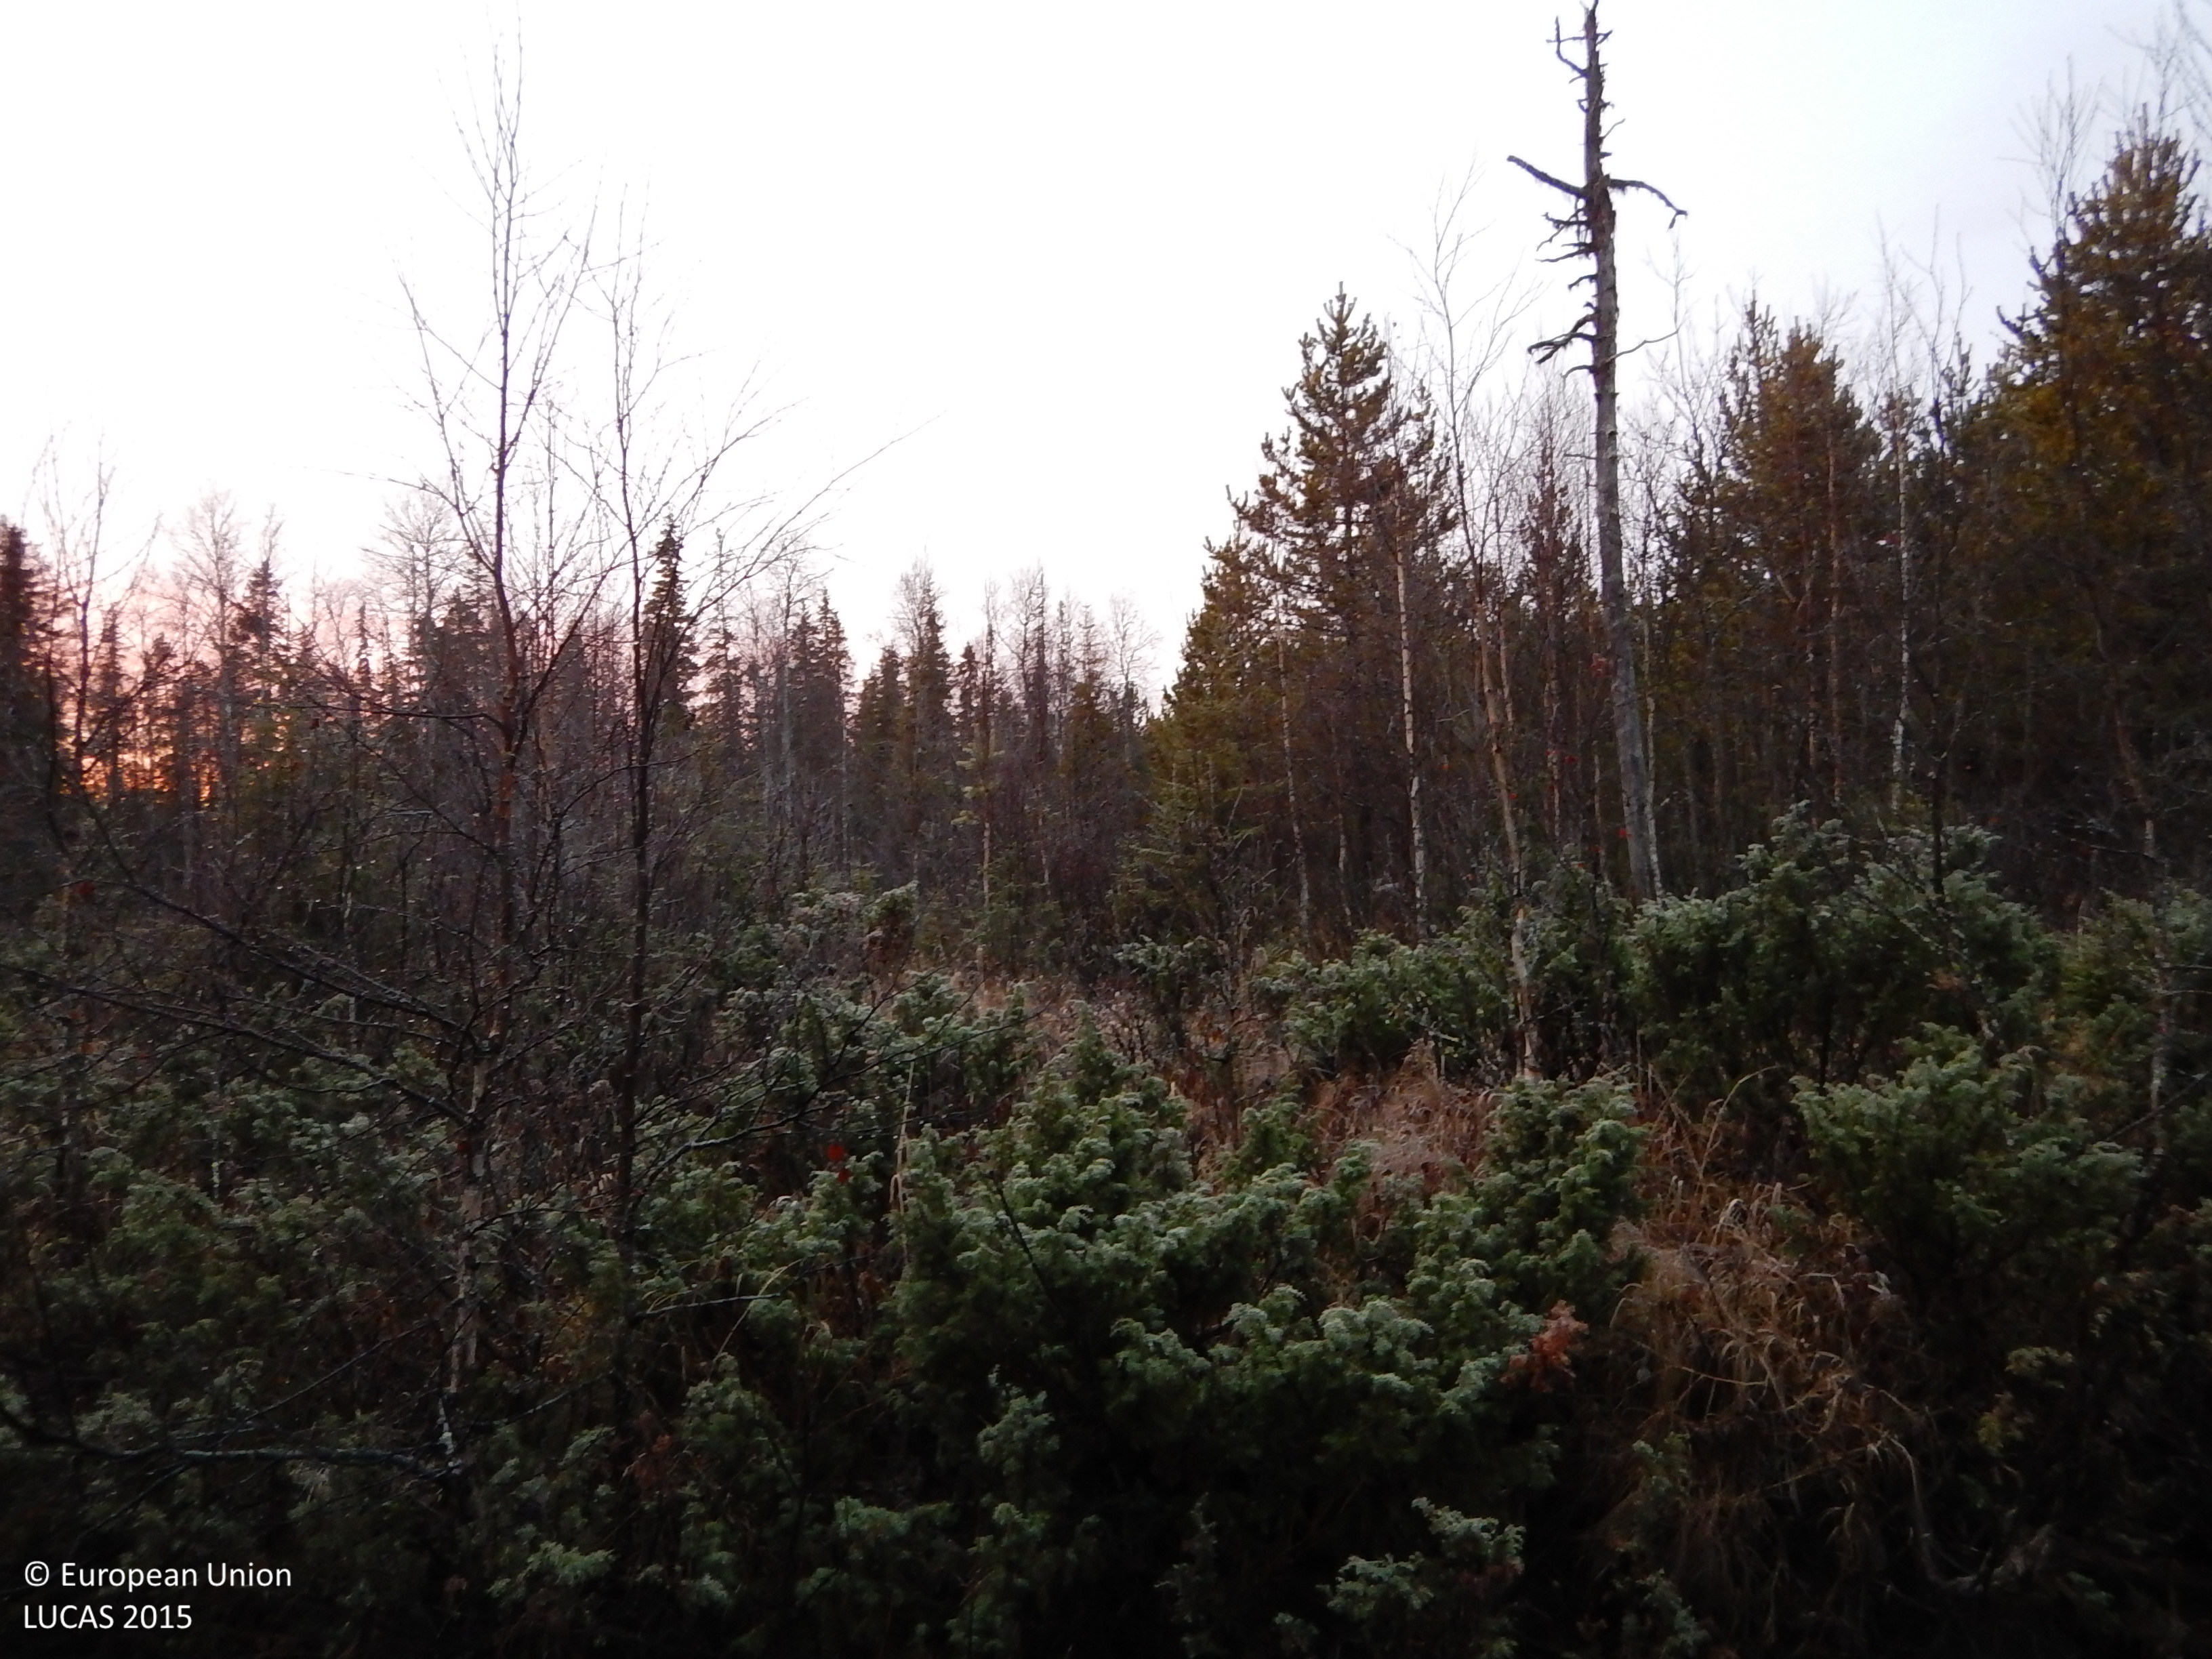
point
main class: Woodland
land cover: Broadleaved woodland
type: mire and swamp forests
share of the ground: 25 - 50 %
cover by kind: broadleaved forest trees 35 %, shrubs 20 %, herbaceous plants 20 %, lichens and mosses 20 %, coniferous forest trees 5 %
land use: Forestry
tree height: > 5 m
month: November
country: SE
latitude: 65.1457
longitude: 20.4828
